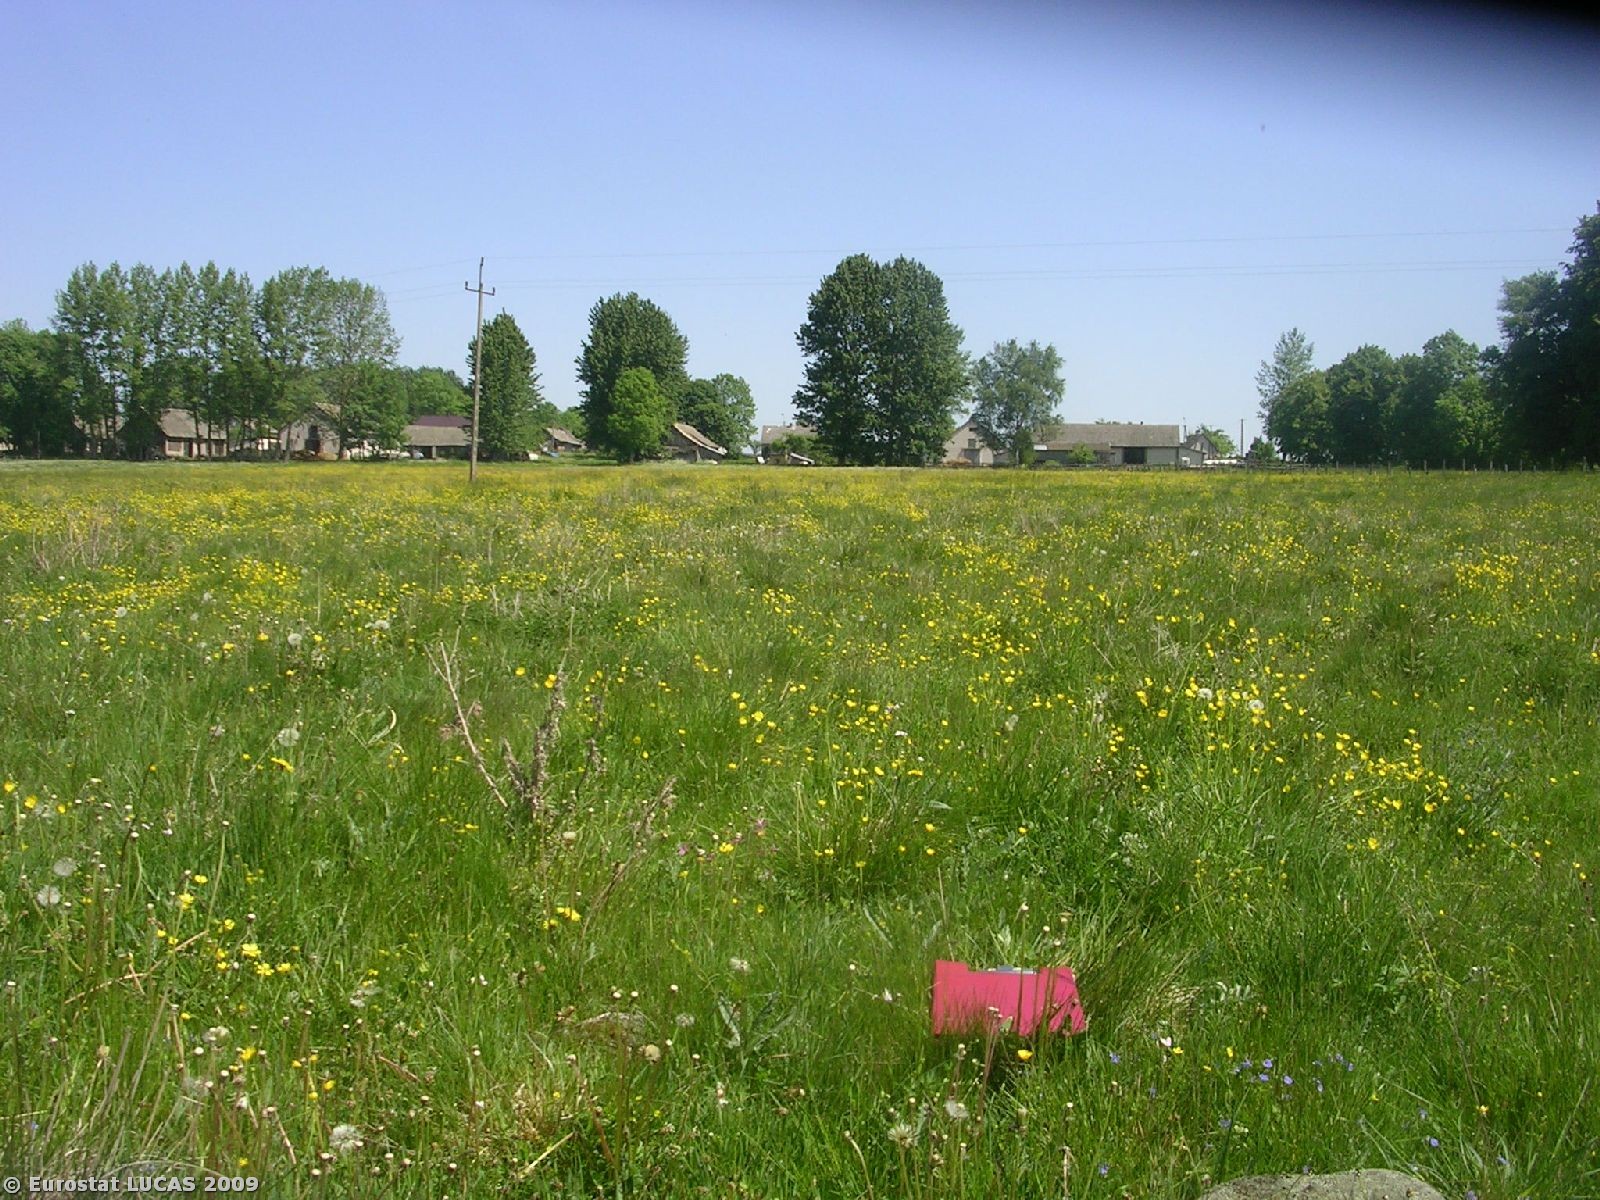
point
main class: Grassland
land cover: Grassland without tree/shrub cover
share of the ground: > 75 %
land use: Agriculture (excluding fallow land and kitchen gardens)
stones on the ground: < 10 %
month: May
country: PL
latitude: 53.5137
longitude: 23.3667
